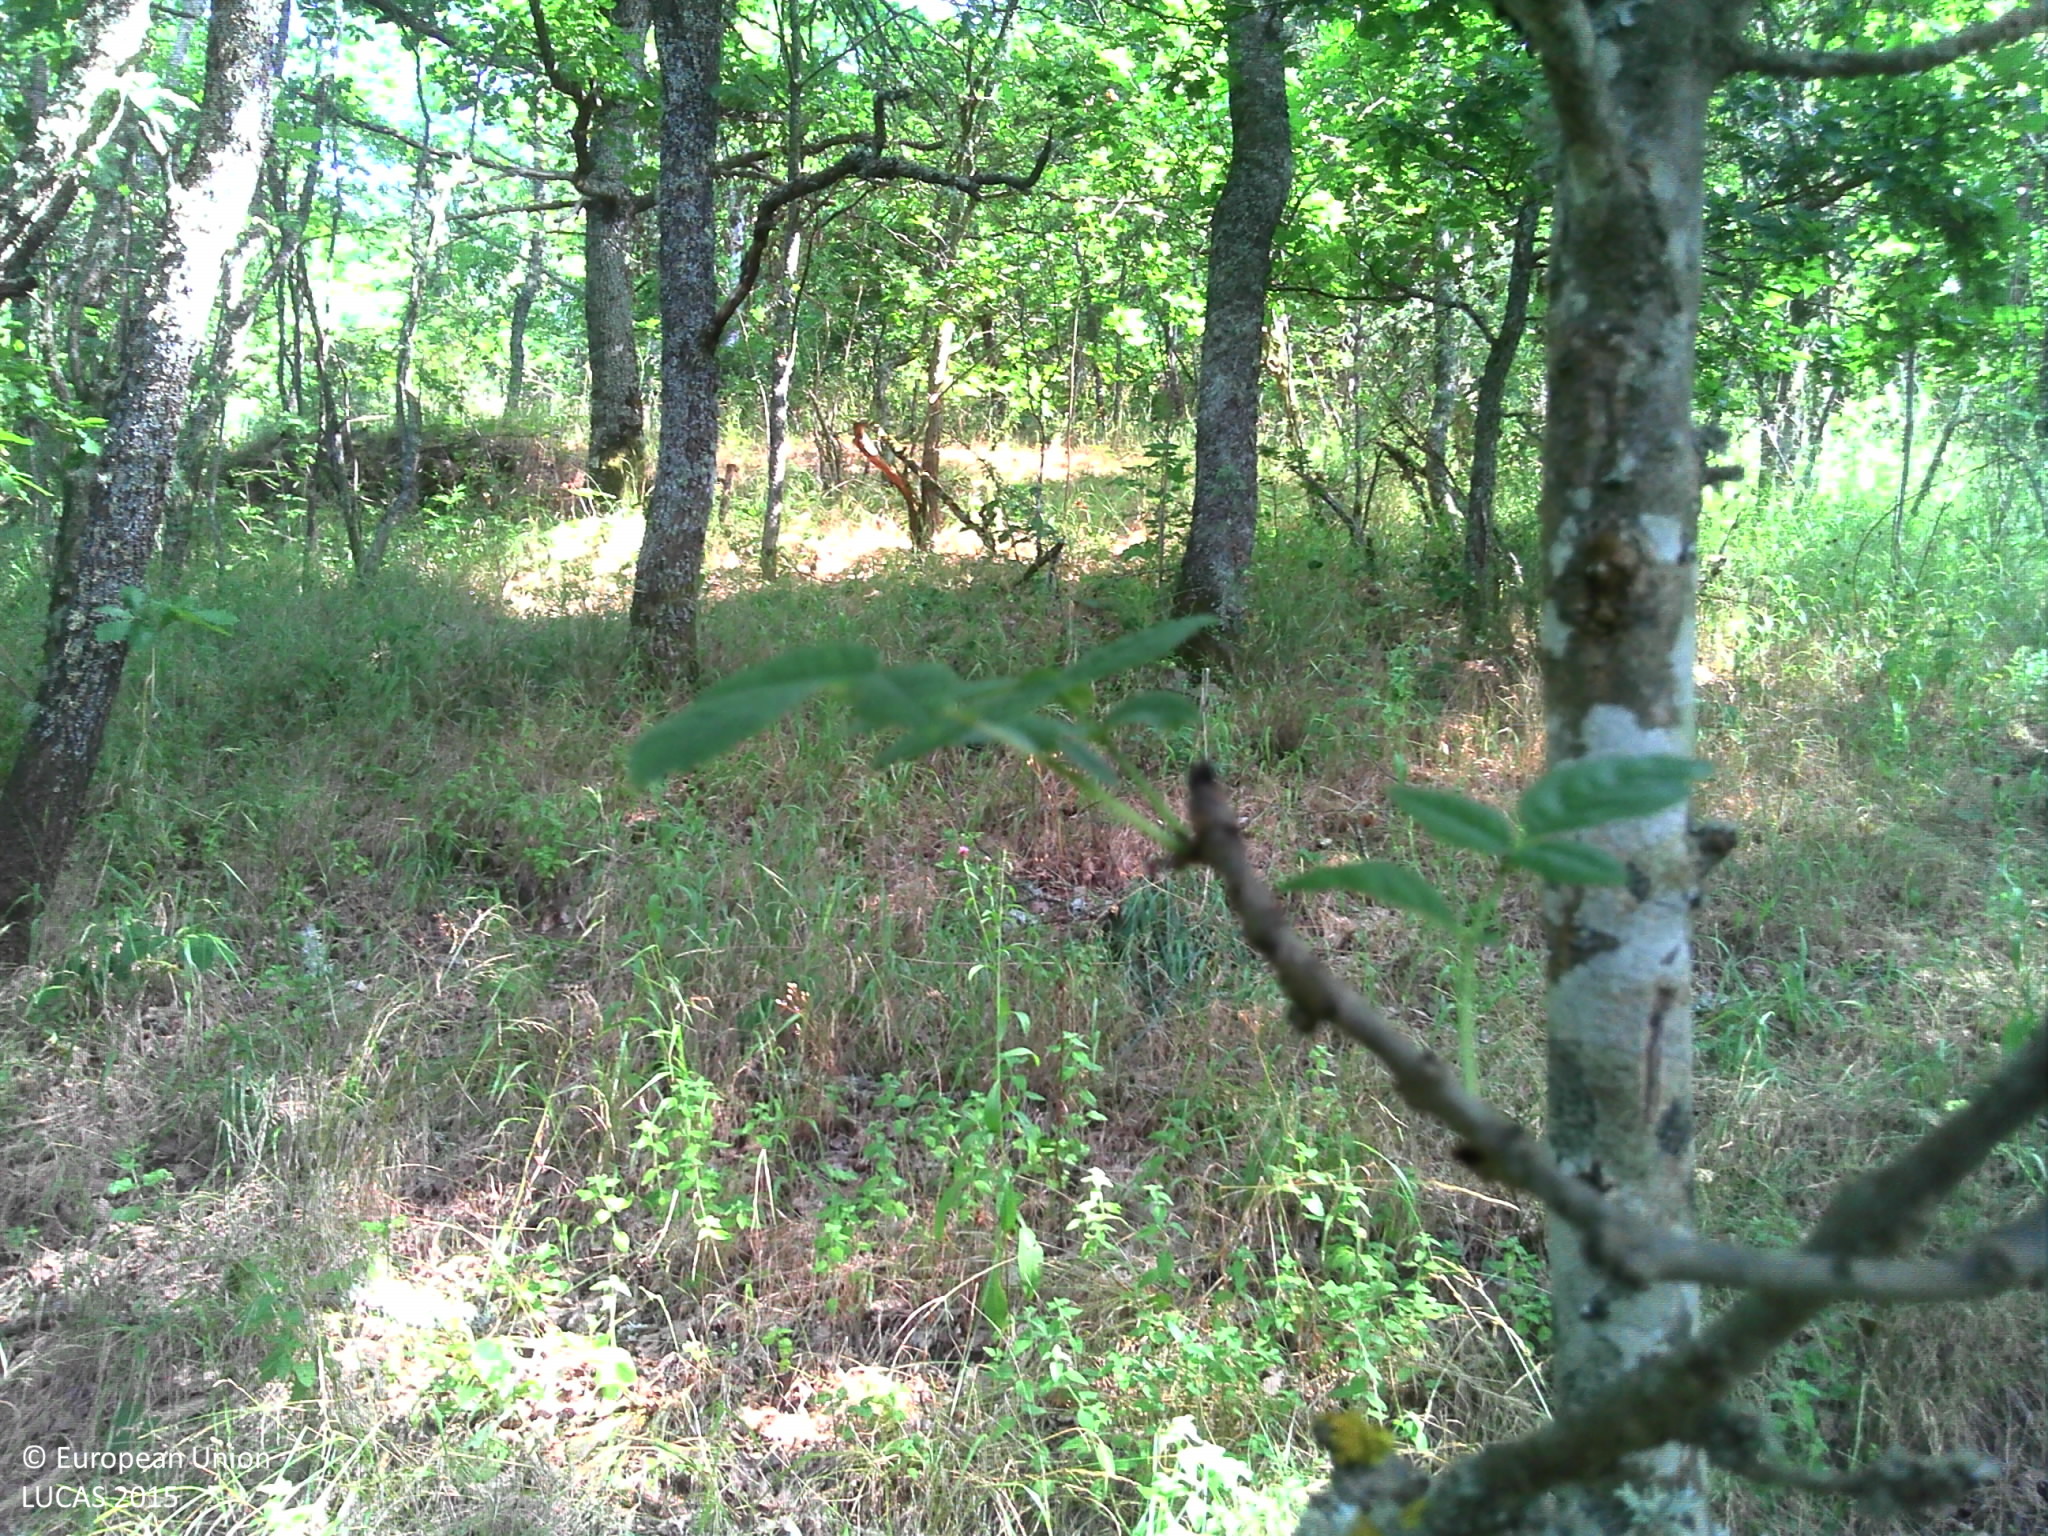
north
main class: Woodland
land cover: Broadleaved woodland
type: mesophytic deciduous forest
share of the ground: > 75 %
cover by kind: broadleaved forest trees 80 %, herbaceous plants 15 %, lichens and mosses 5 %
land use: Forestry
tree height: > 5 m
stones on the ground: 25 - 50 %
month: July
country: FR
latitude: 45.3599
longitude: 4.1440
